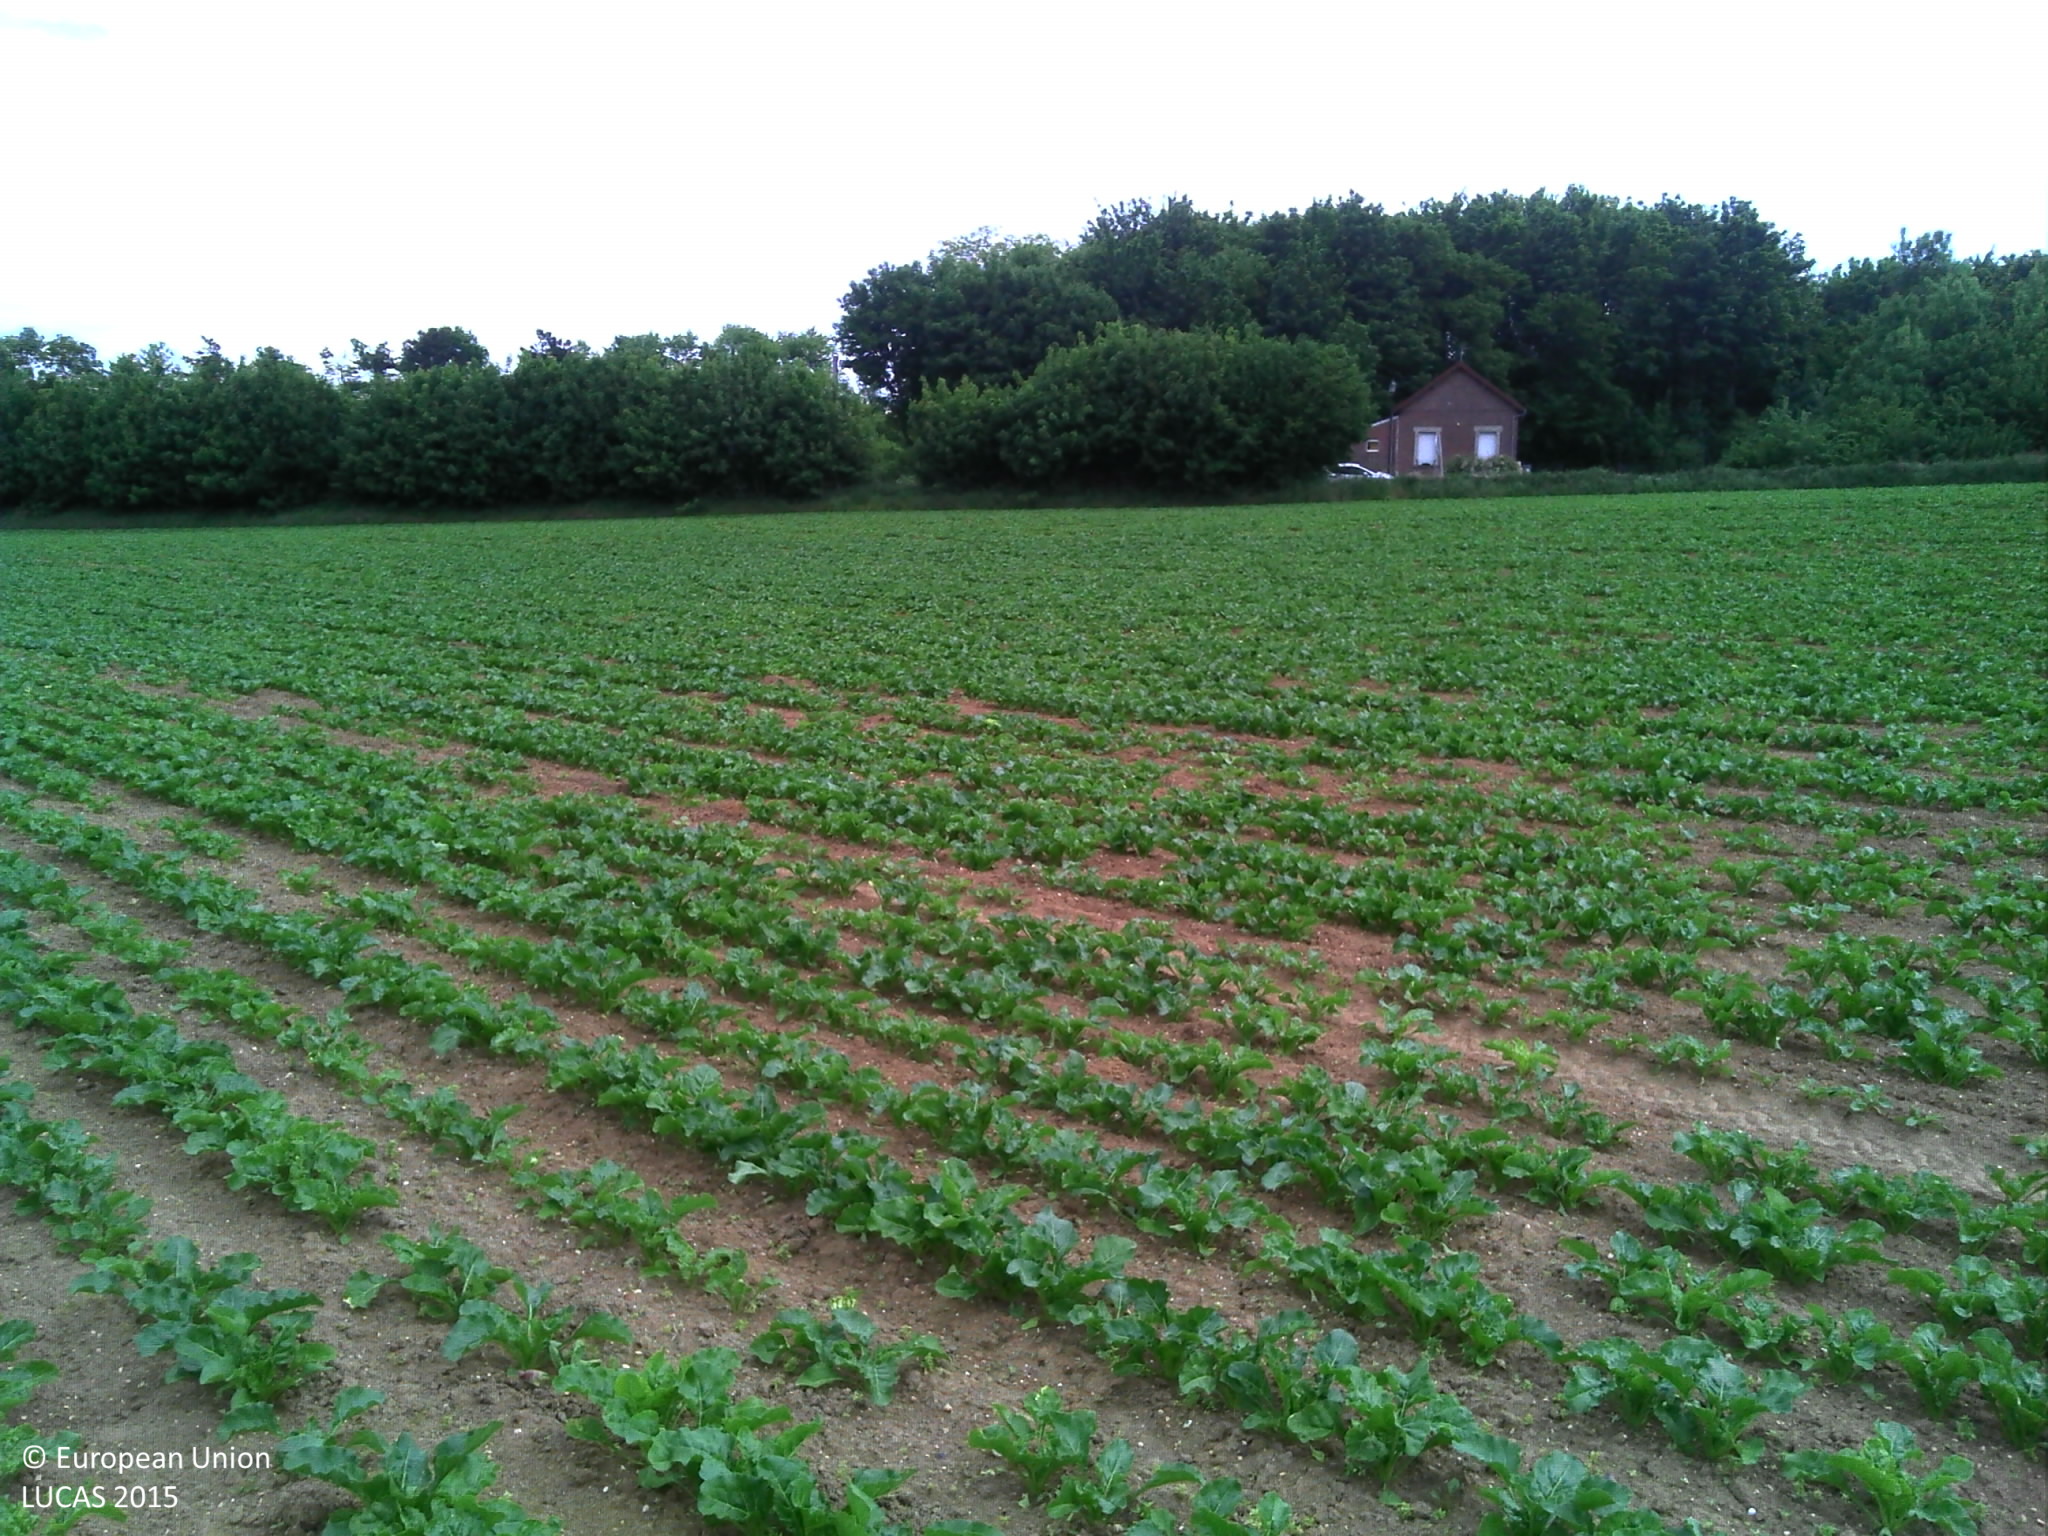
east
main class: Cropland
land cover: Sugar beet
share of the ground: > 75 %
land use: Agriculture (excluding fallow land and kitchen gardens)
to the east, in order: Sugar beet; Fences; Lines of trees; Grassland without tree/shrub cover; Paved roads, cycling and walking lanes; Grass margins; Ditches and canals; Electric lines; Broadleaved woodland; Common wheat; Spontaneously vegetated surfaces; Spruce dominated mixed woodland
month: May
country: FR
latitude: 49.9649
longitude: 3.2300
